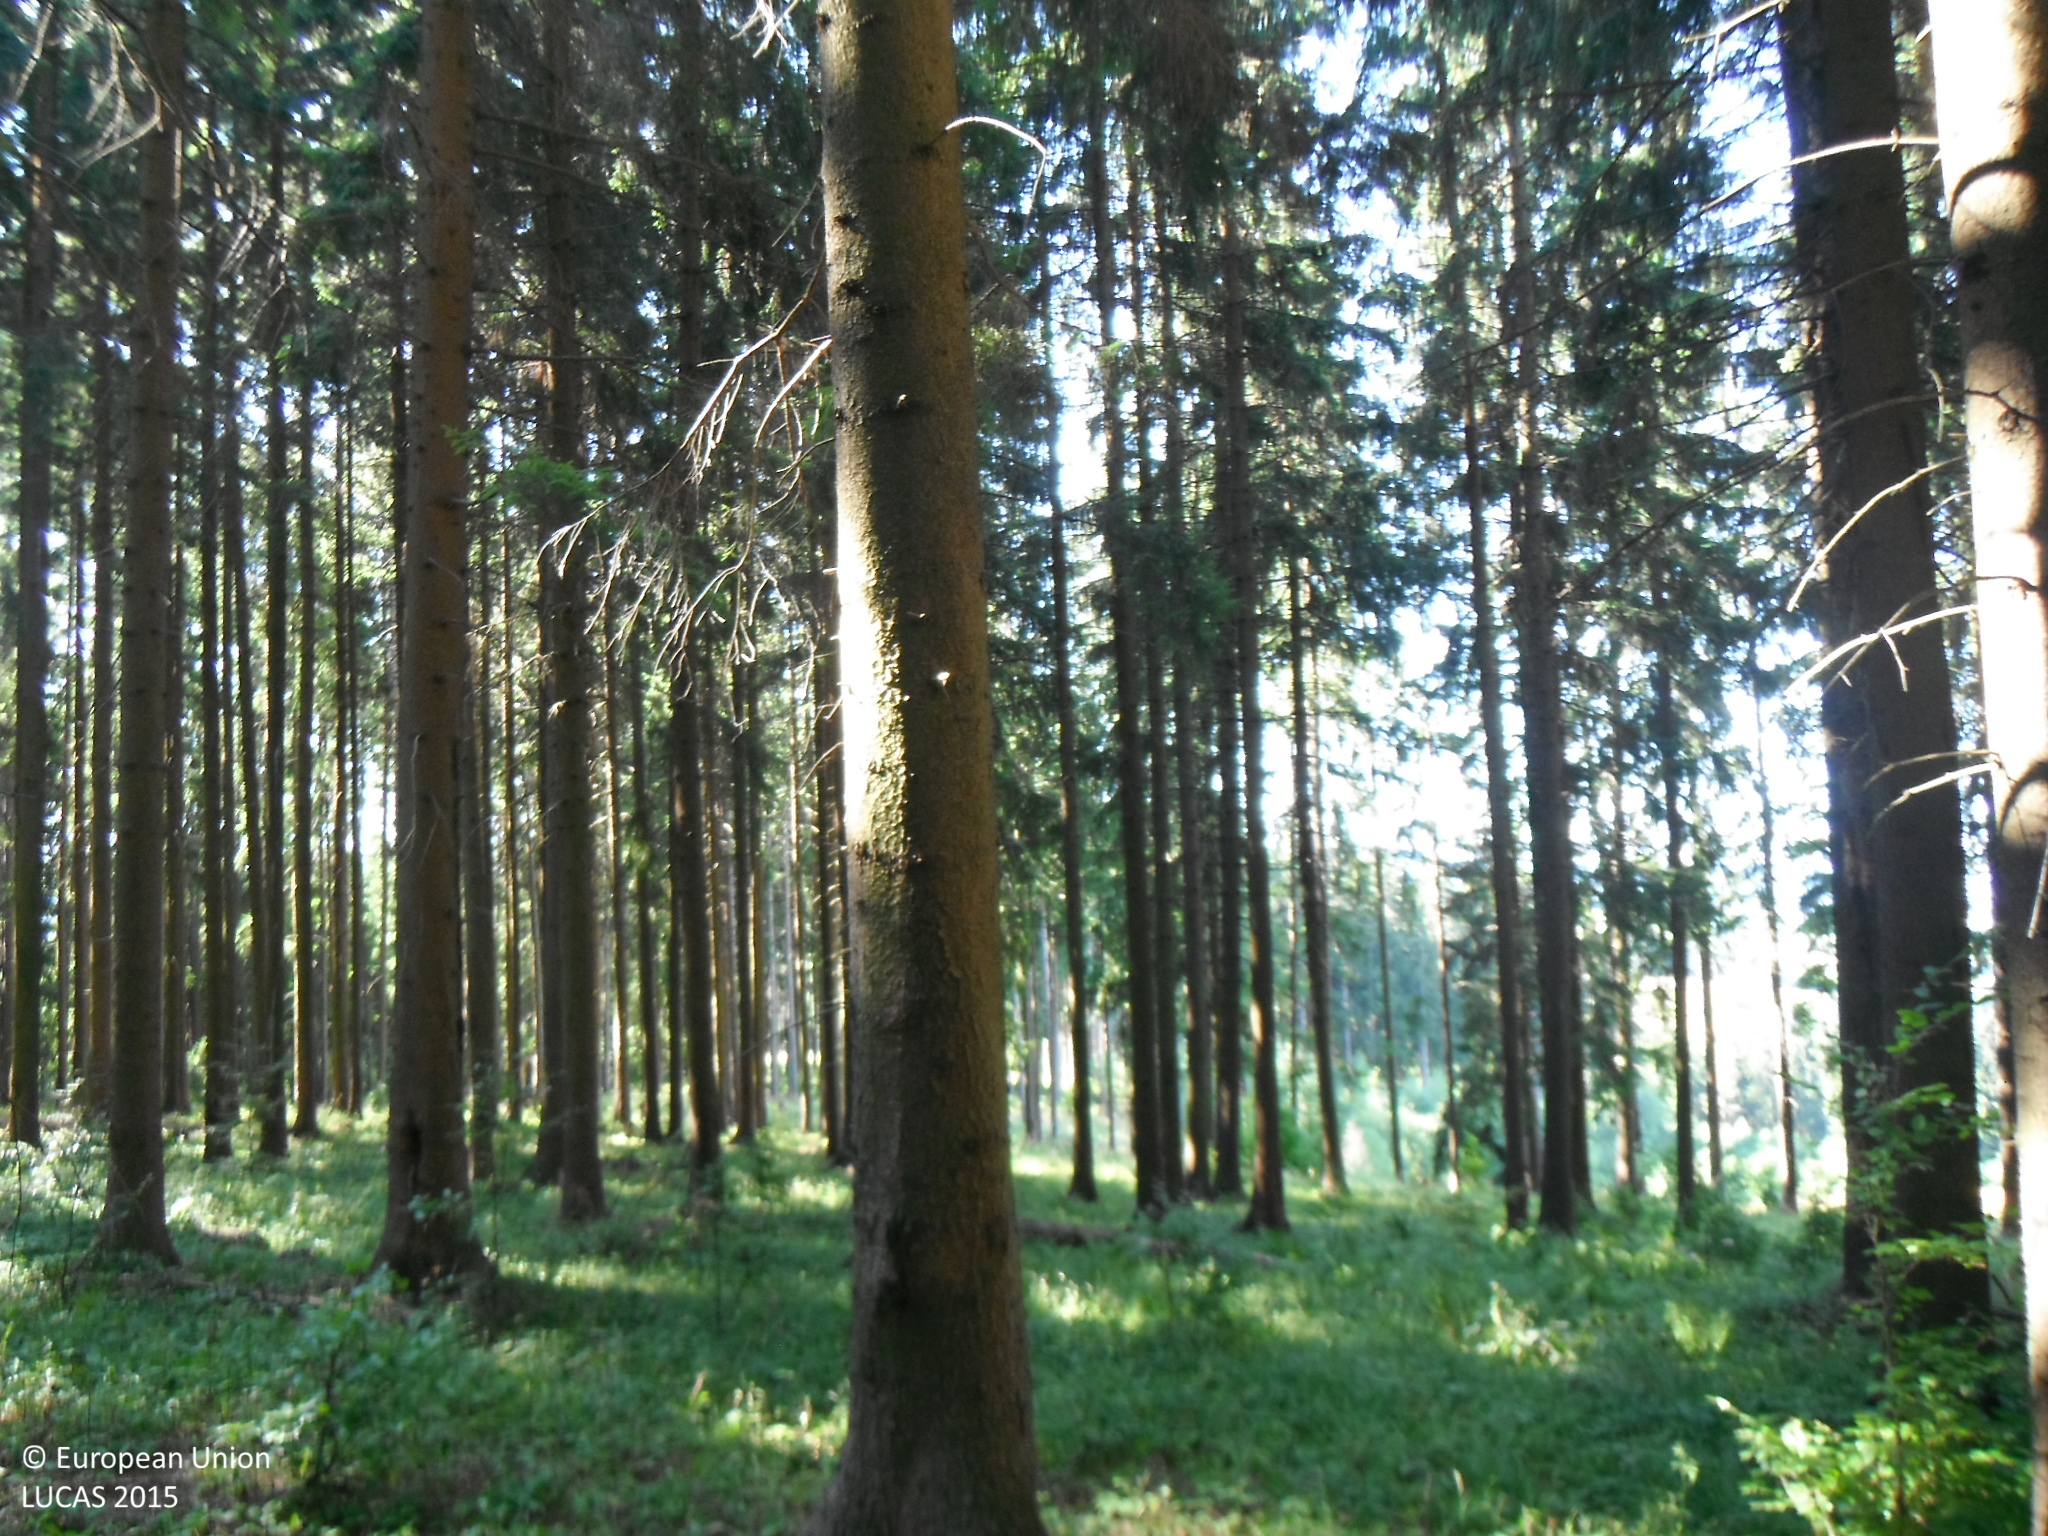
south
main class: Woodland
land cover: Spruce dominated coniferous woodland
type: alpine coniferous forest
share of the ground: > 75 %
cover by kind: coniferous forest trees 90 %, herbaceous plants 5 %, unconsolidated bare surface 5 %
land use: Forestry
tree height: > 5 m
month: August
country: SK
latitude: 49.1354
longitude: 18.1157
